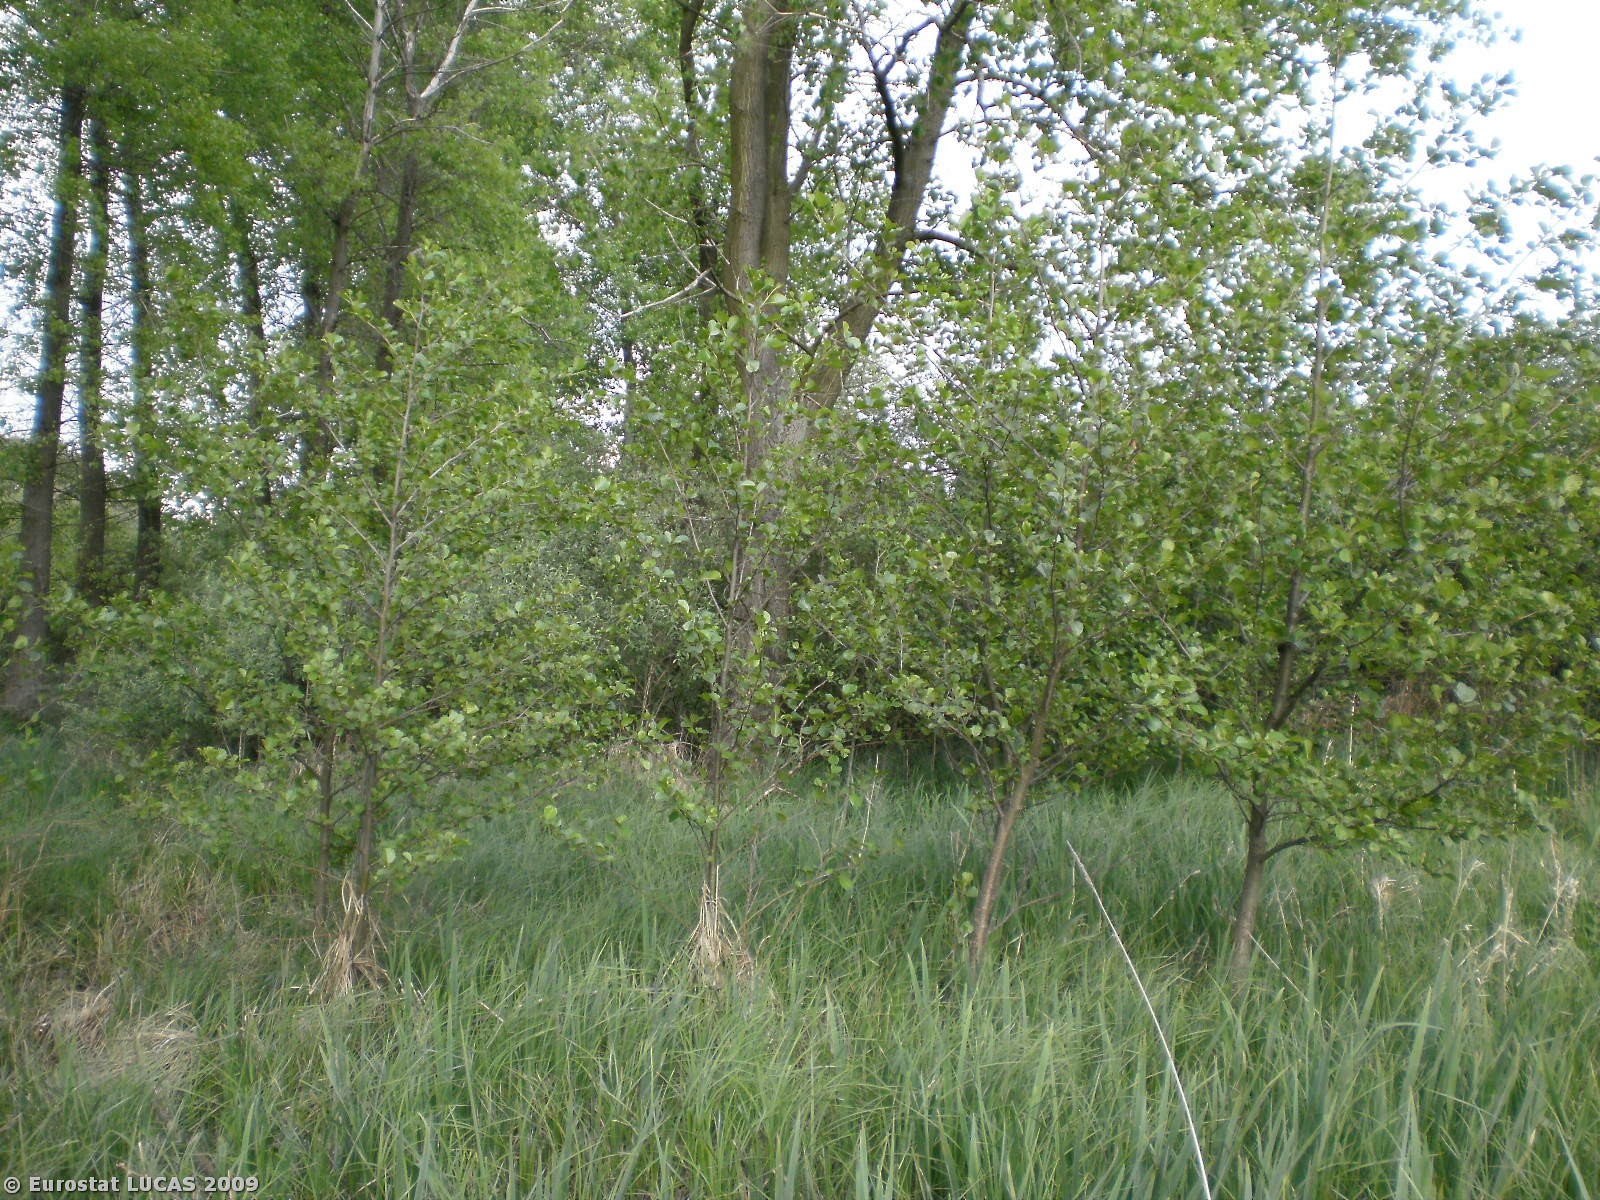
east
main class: Woodland
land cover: Broadleaved woodland
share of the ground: > 75 %
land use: Forestry
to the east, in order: Broadleaved woodland; Grassland with sparse tree/shrub cover; Shrubland without tree cover; Grassland without tree/shrub cover; Shrubland with sparse tree cover; Inland marshes; Broadleaved woodland
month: May
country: PL
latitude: 53.3183
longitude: 17.7139
